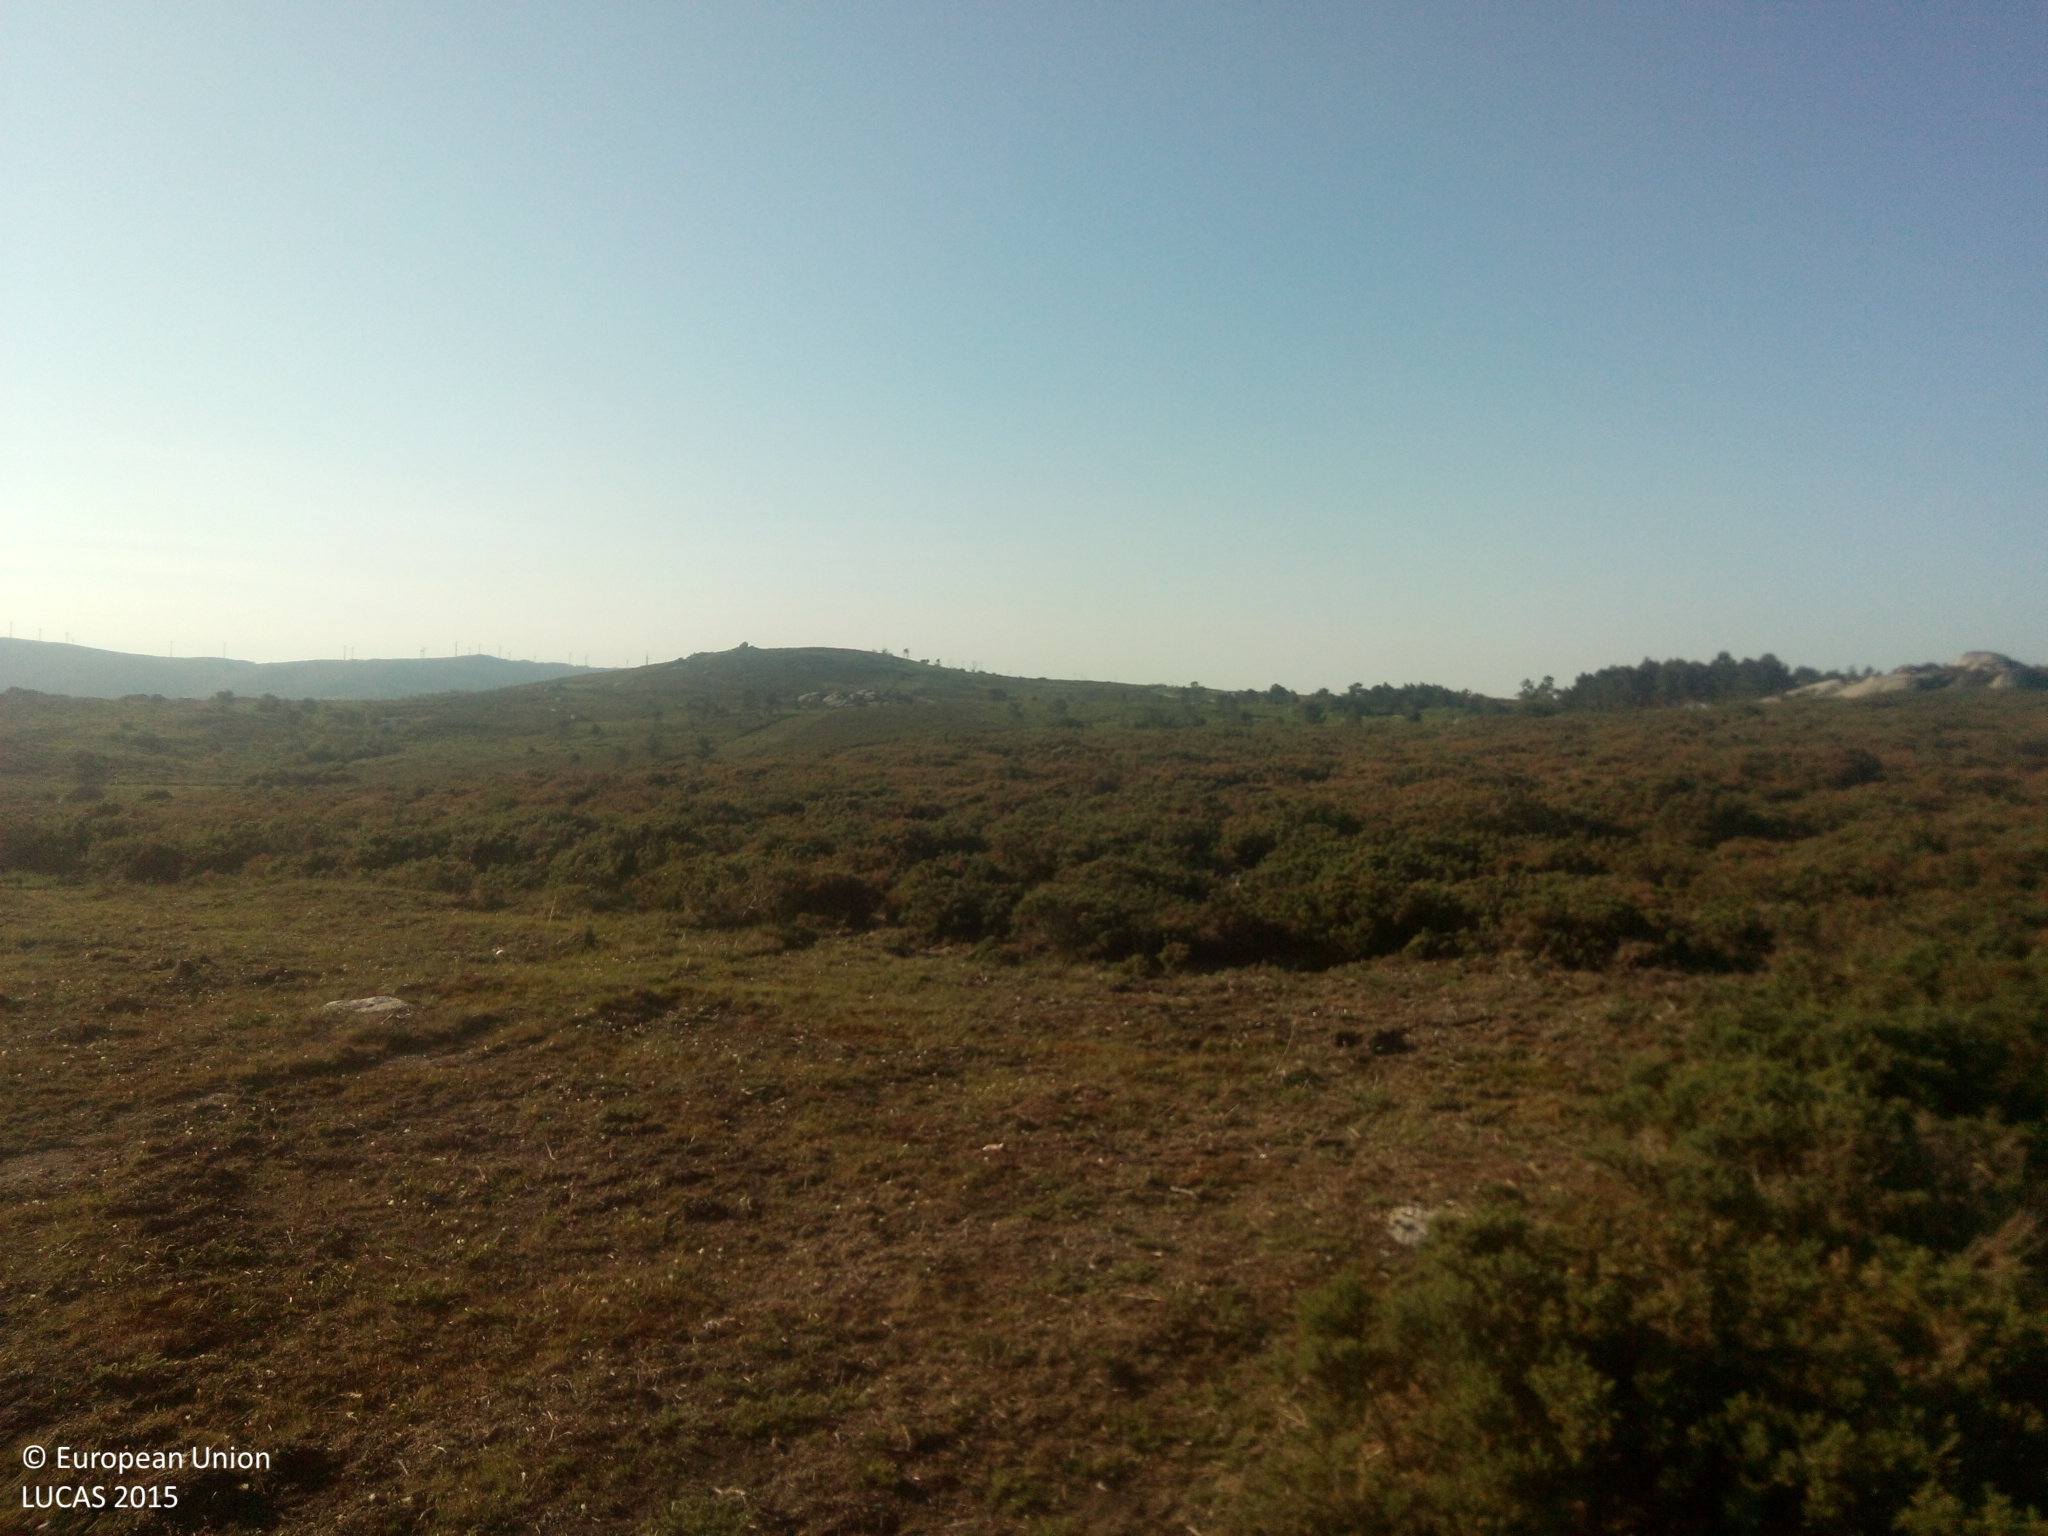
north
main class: Shrubland
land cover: Shrubland without tree cover
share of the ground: > 75 %
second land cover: Other bare soil
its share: > 75 %
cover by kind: shrubs 100 %
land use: Semi-natural and natural areas not in use
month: June
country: ES
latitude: 42.4226
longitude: -8.3345
